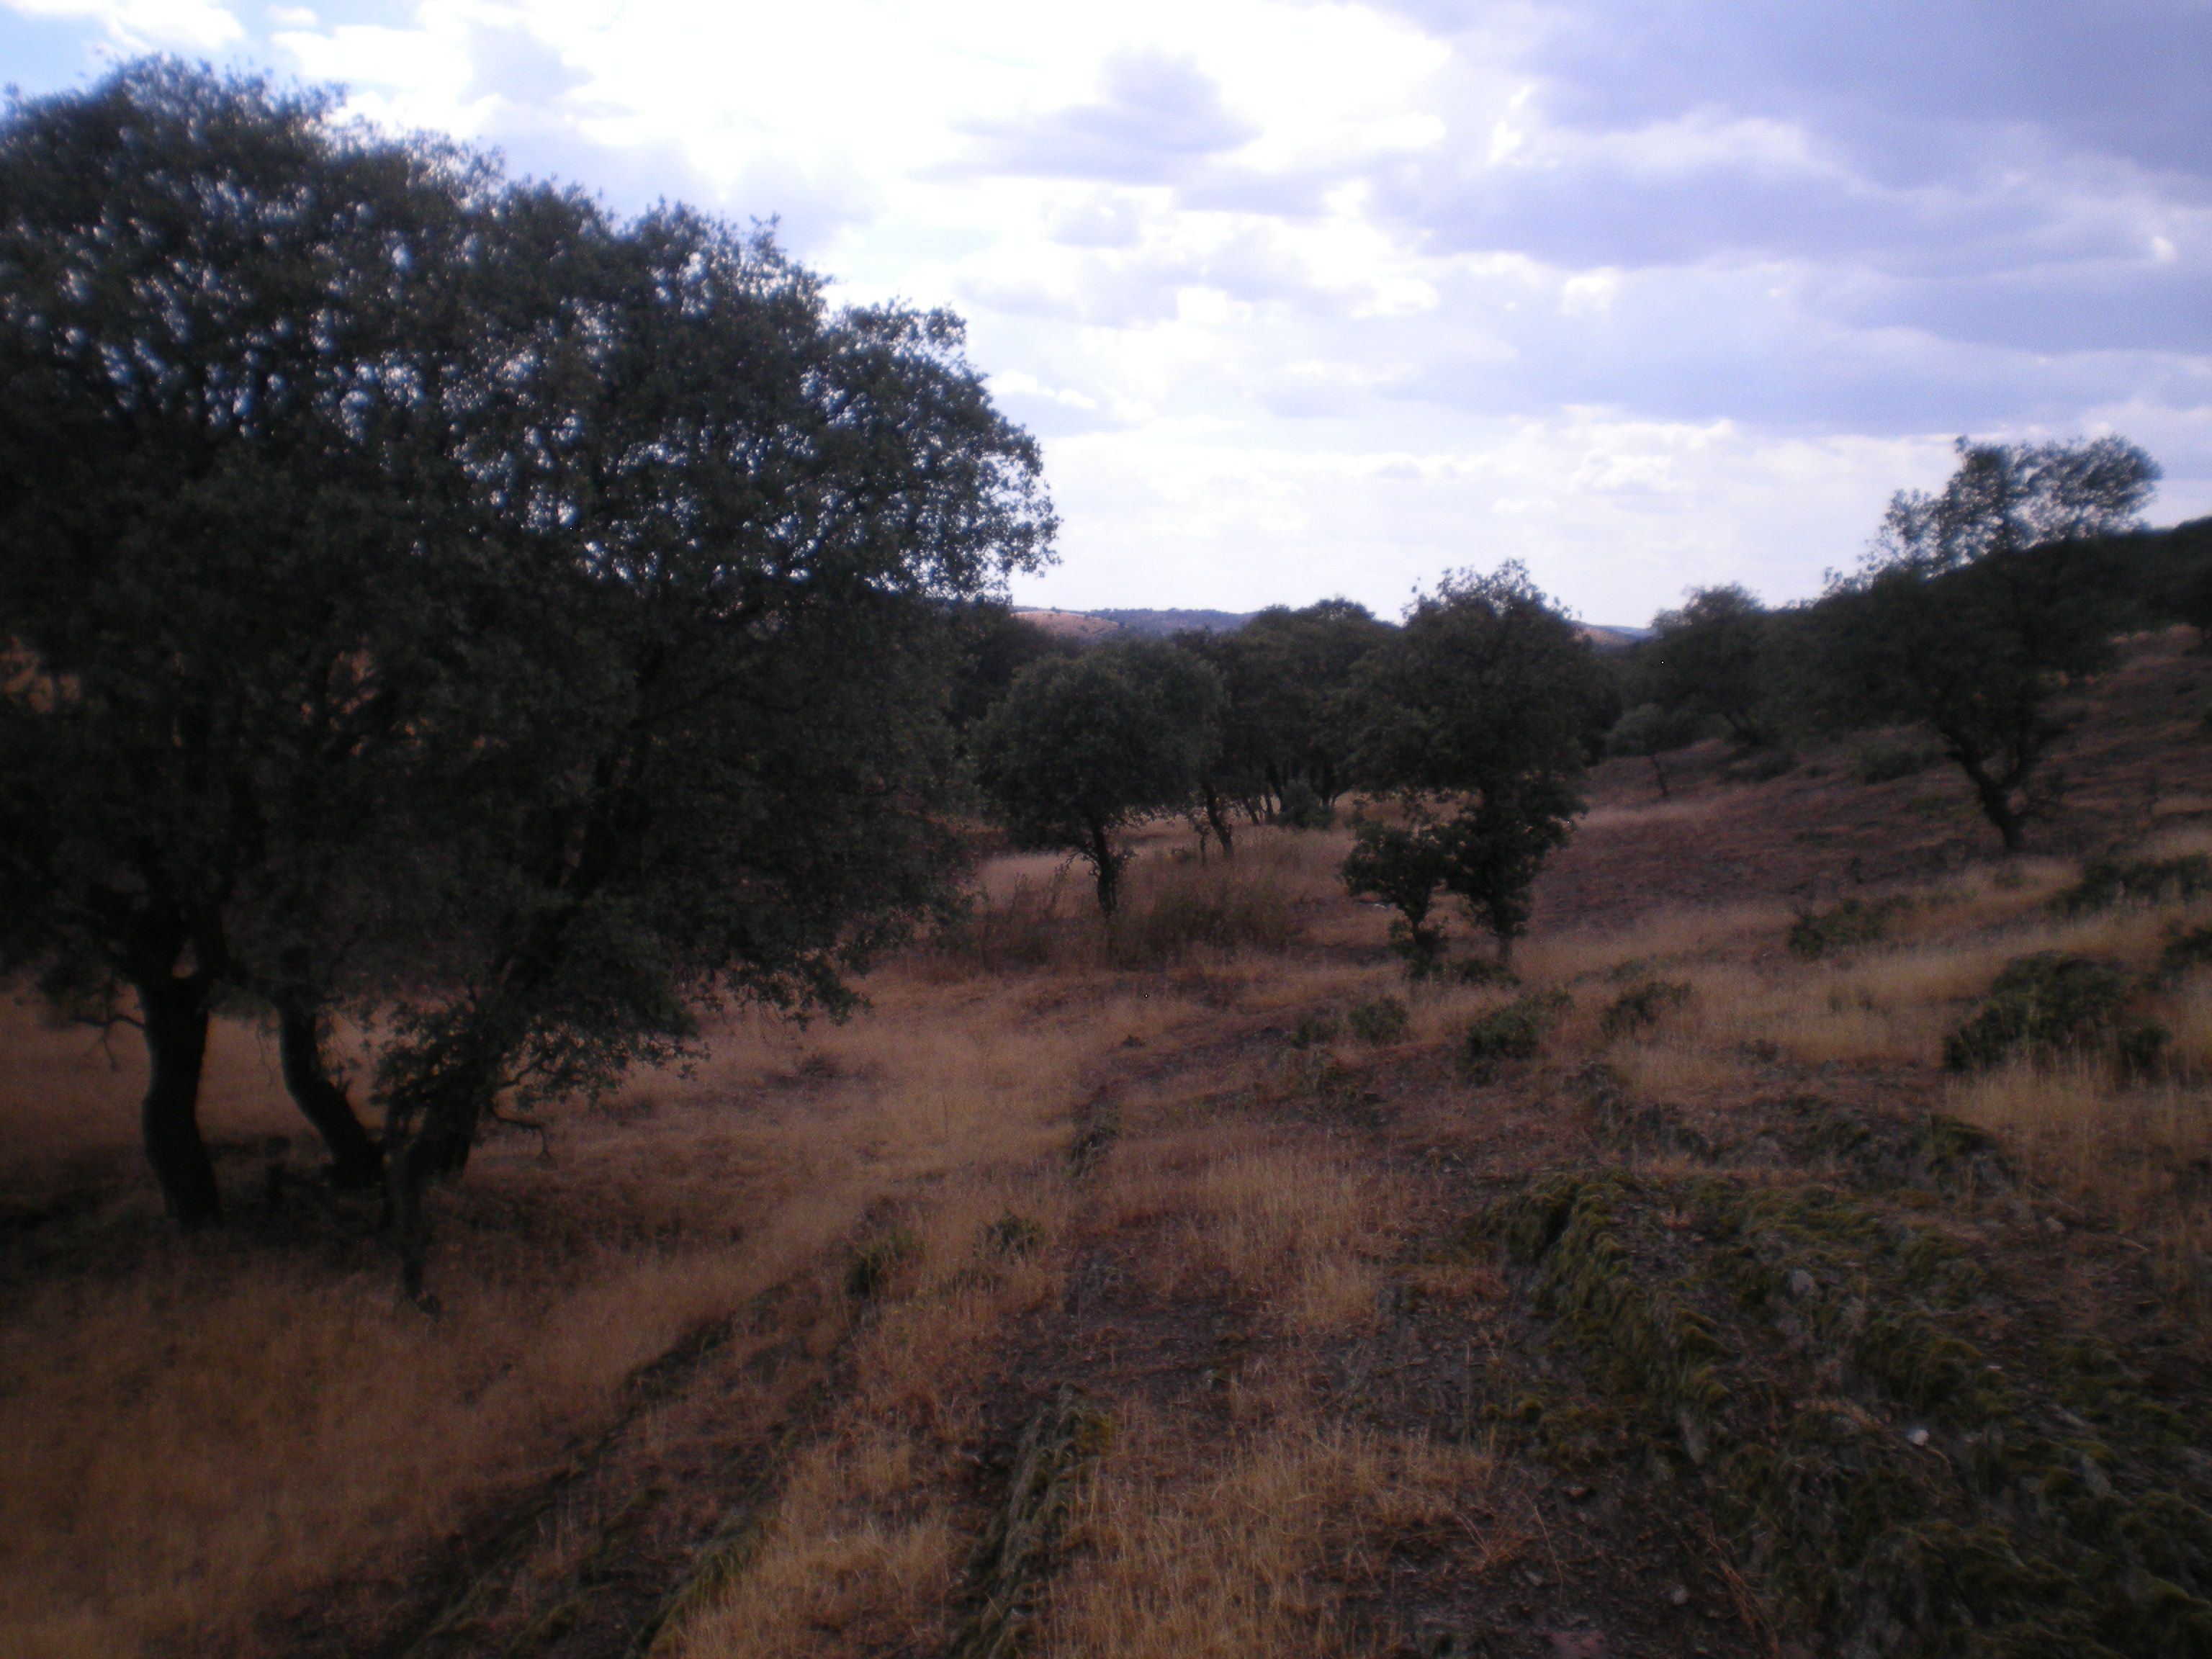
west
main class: Grassland
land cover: Grassland with sparse tree/shrub cover
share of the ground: 10 - 25 %
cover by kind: unconsolidated bare surface 80 %, herbaceous plants 15 %, broadleaved forest trees 5 %
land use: Agriculture (excluding fallow land and kitchen gardens)
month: June
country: ES
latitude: 38.4519
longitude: -3.3557
